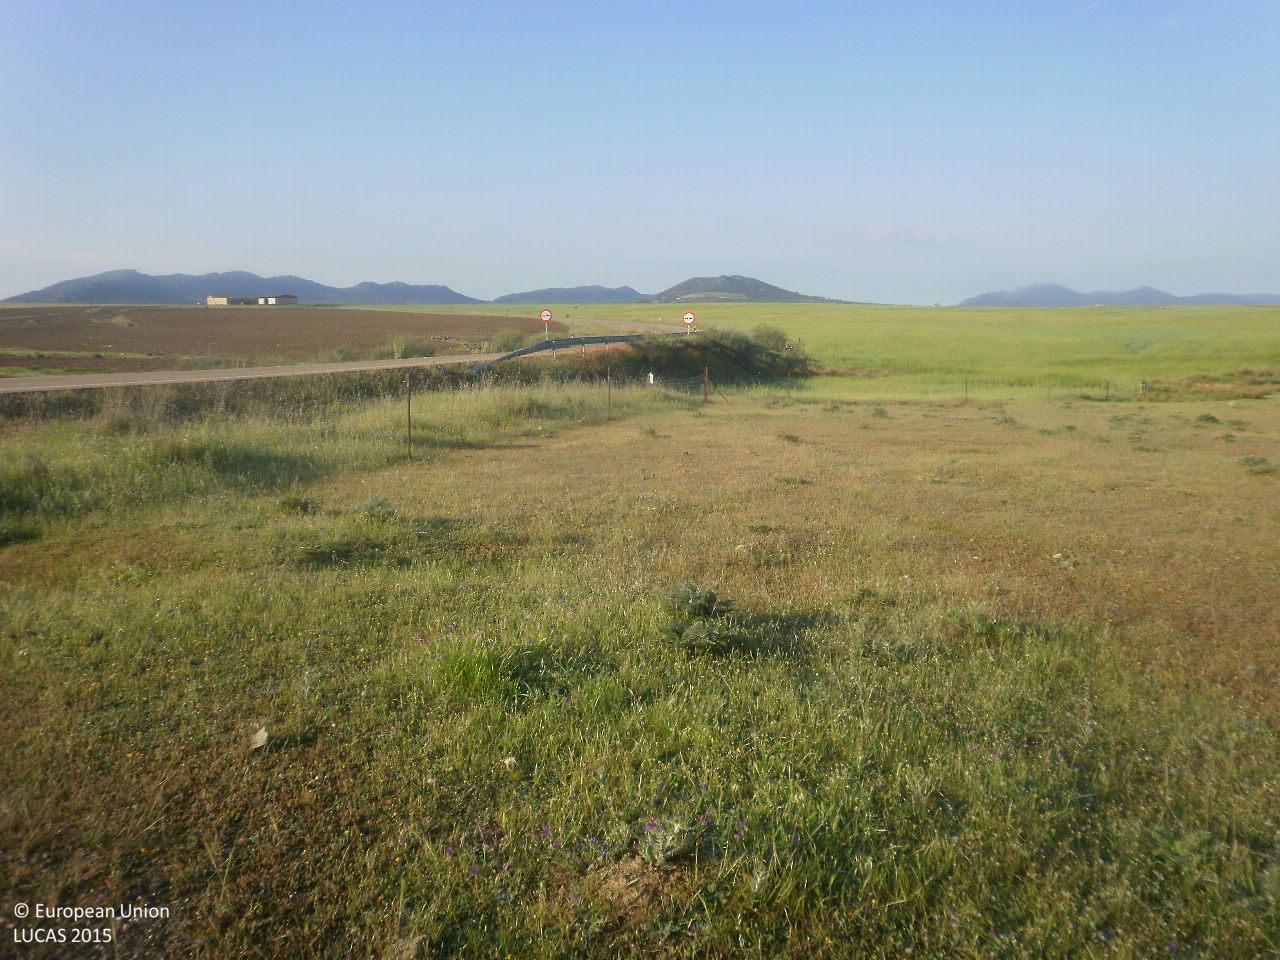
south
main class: Grassland
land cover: Grassland without tree/shrub cover
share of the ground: > 75 %
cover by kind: herbaceous plants 100 %
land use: Agriculture (excluding fallow land and kitchen gardens)
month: April
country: ES
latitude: 38.7782
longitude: -5.2183
